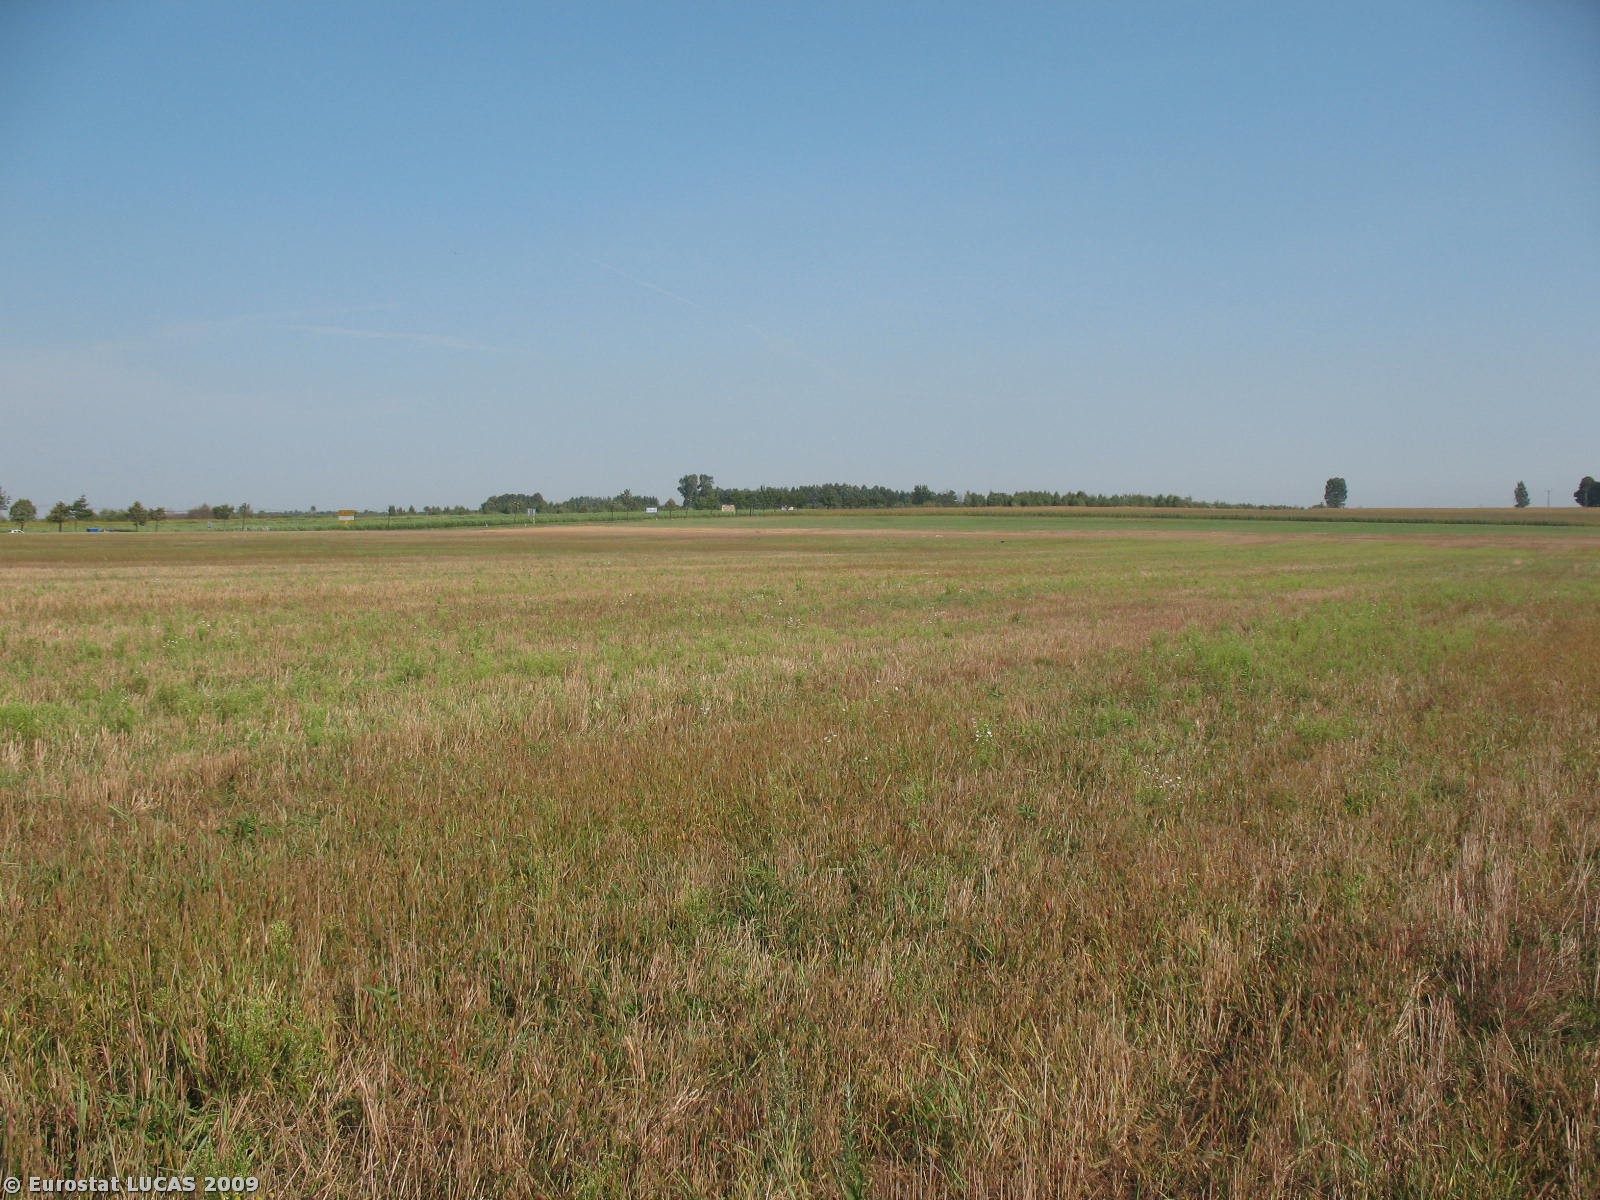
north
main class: Cropland
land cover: Mixed cereals for fodder
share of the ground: < 10 %
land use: Agriculture (excluding fallow land and kitchen gardens)
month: September
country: PL
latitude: 50.2428
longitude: 22.1327
